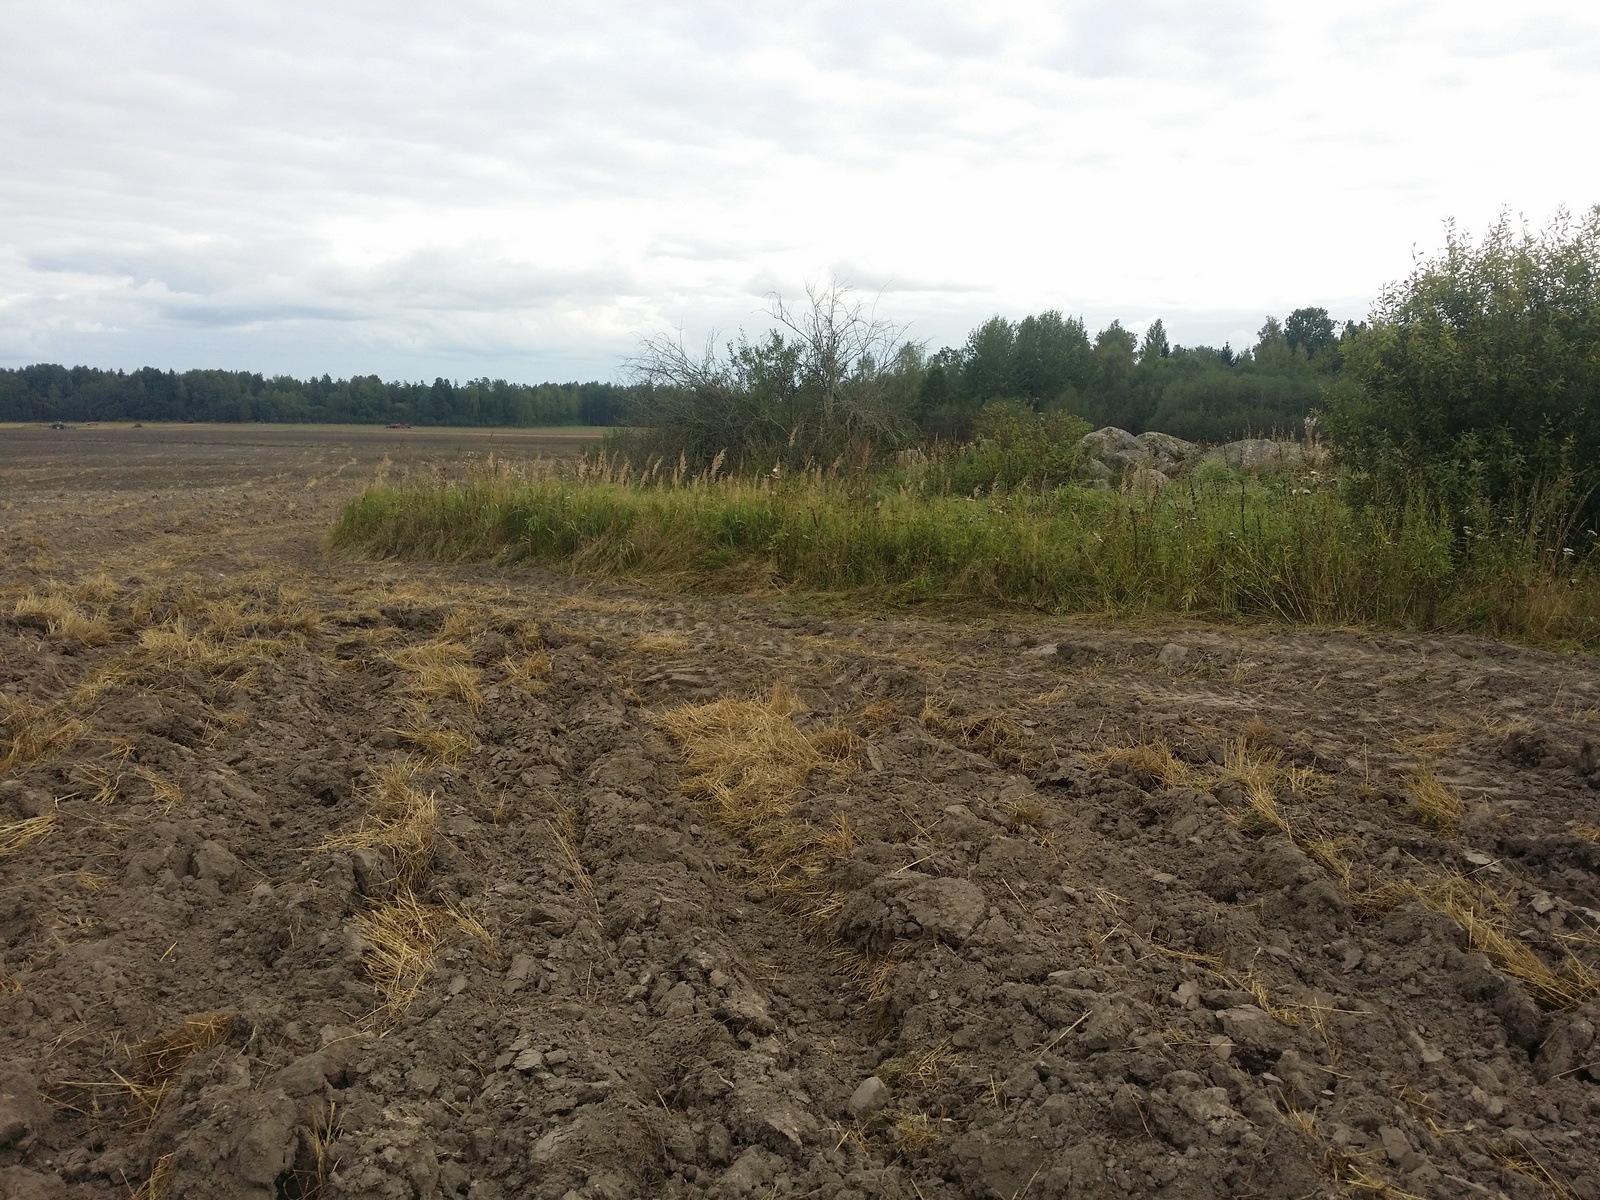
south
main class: Cropland
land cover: Common wheat
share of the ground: < 10 %
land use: Agriculture (excluding fallow land and kitchen gardens)
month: September
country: LV
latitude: 57.0167
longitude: 27.1117
